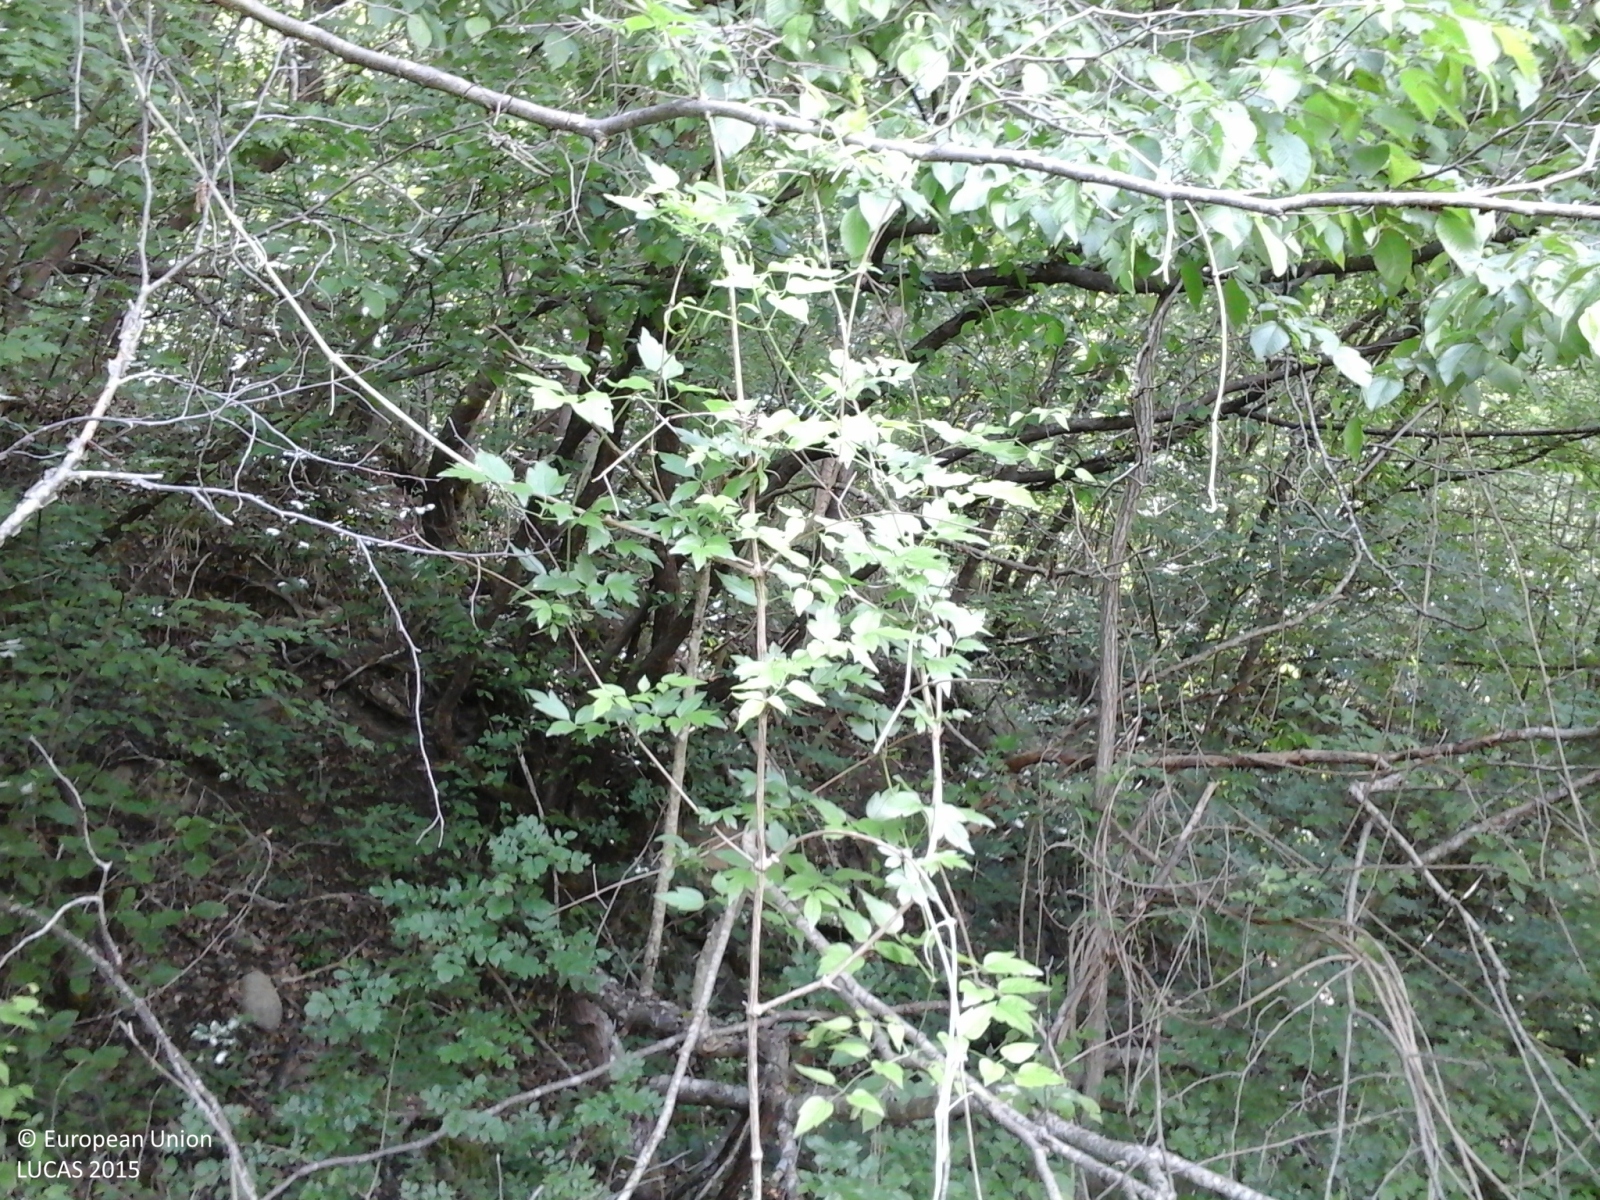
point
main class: Woodland
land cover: Broadleaved woodland
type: thermophilous deciduous forest
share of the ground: > 75 %
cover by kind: broadleaved forest trees 80 %, shrubs 20 %
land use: Forestry
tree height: > 5 m
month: May
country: IT
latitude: 44.5850
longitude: 9.9120
